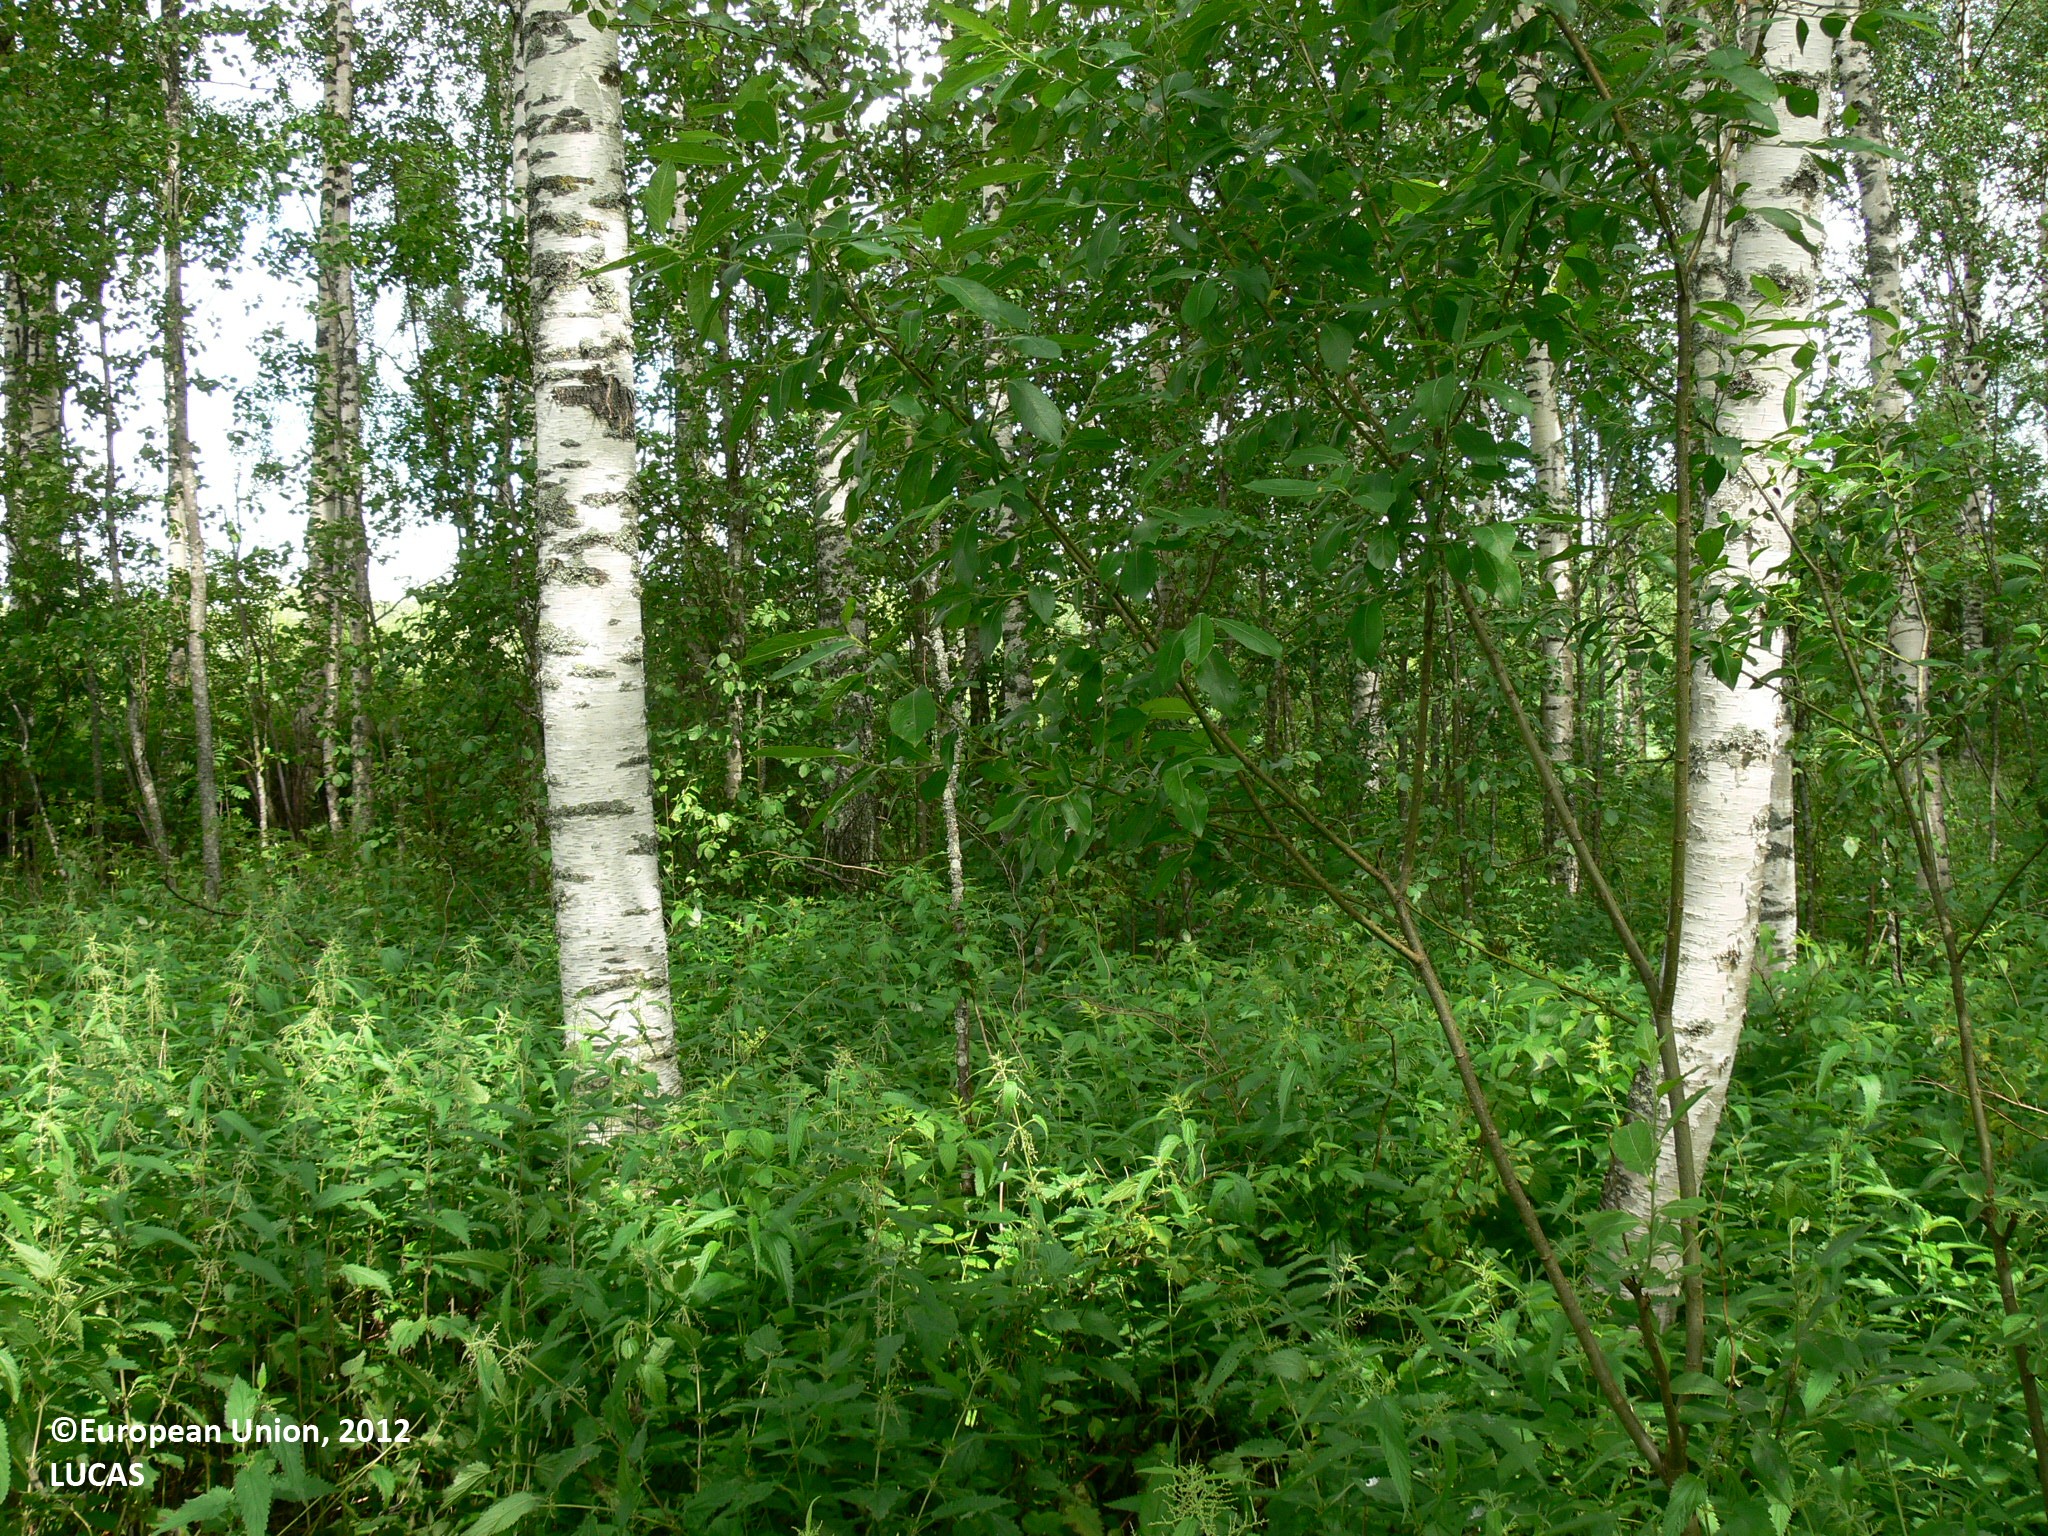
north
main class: Woodland
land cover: Broadleaved woodland
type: boreal forest
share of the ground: > 75 %
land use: Forestry
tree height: > 5 m
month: July
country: FI
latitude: 63.1694
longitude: 30.0536
